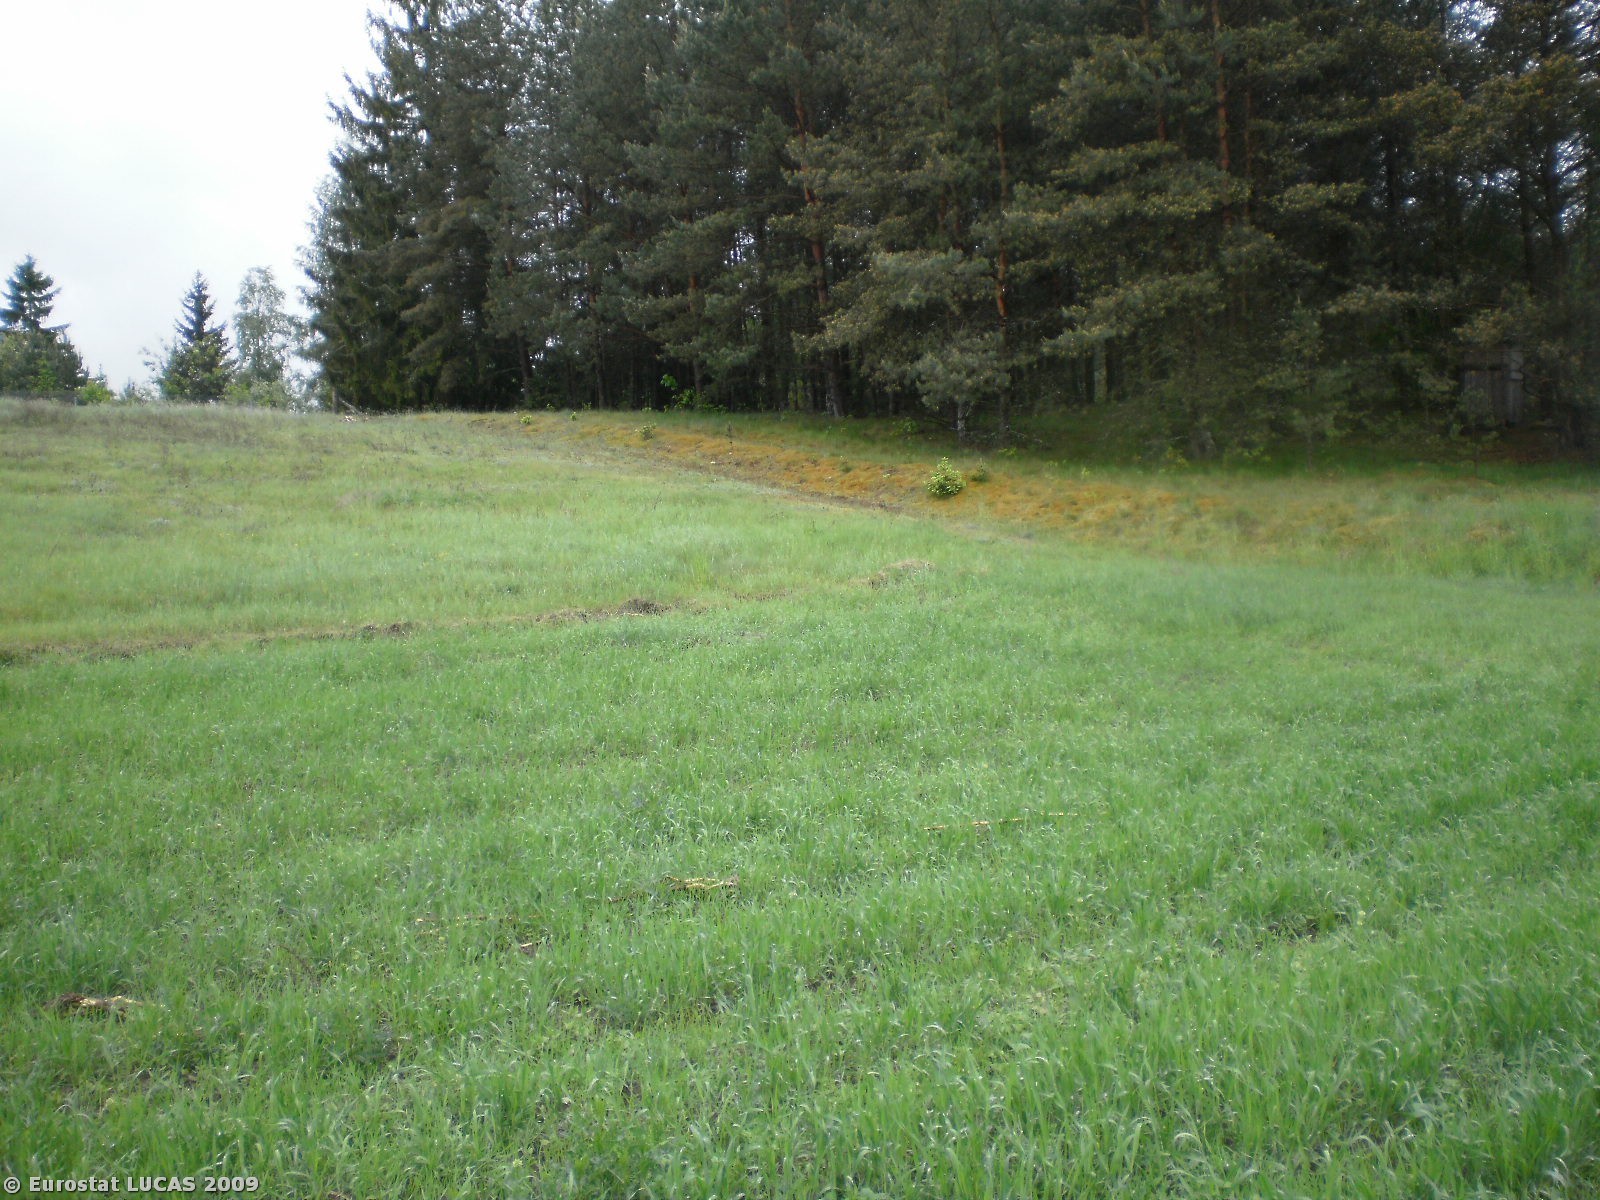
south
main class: Grassland
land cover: Grassland without tree/shrub cover
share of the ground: > 75 %
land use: Agriculture (excluding fallow land and kitchen gardens)
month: May
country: PL
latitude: 53.8738
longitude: 18.0606
